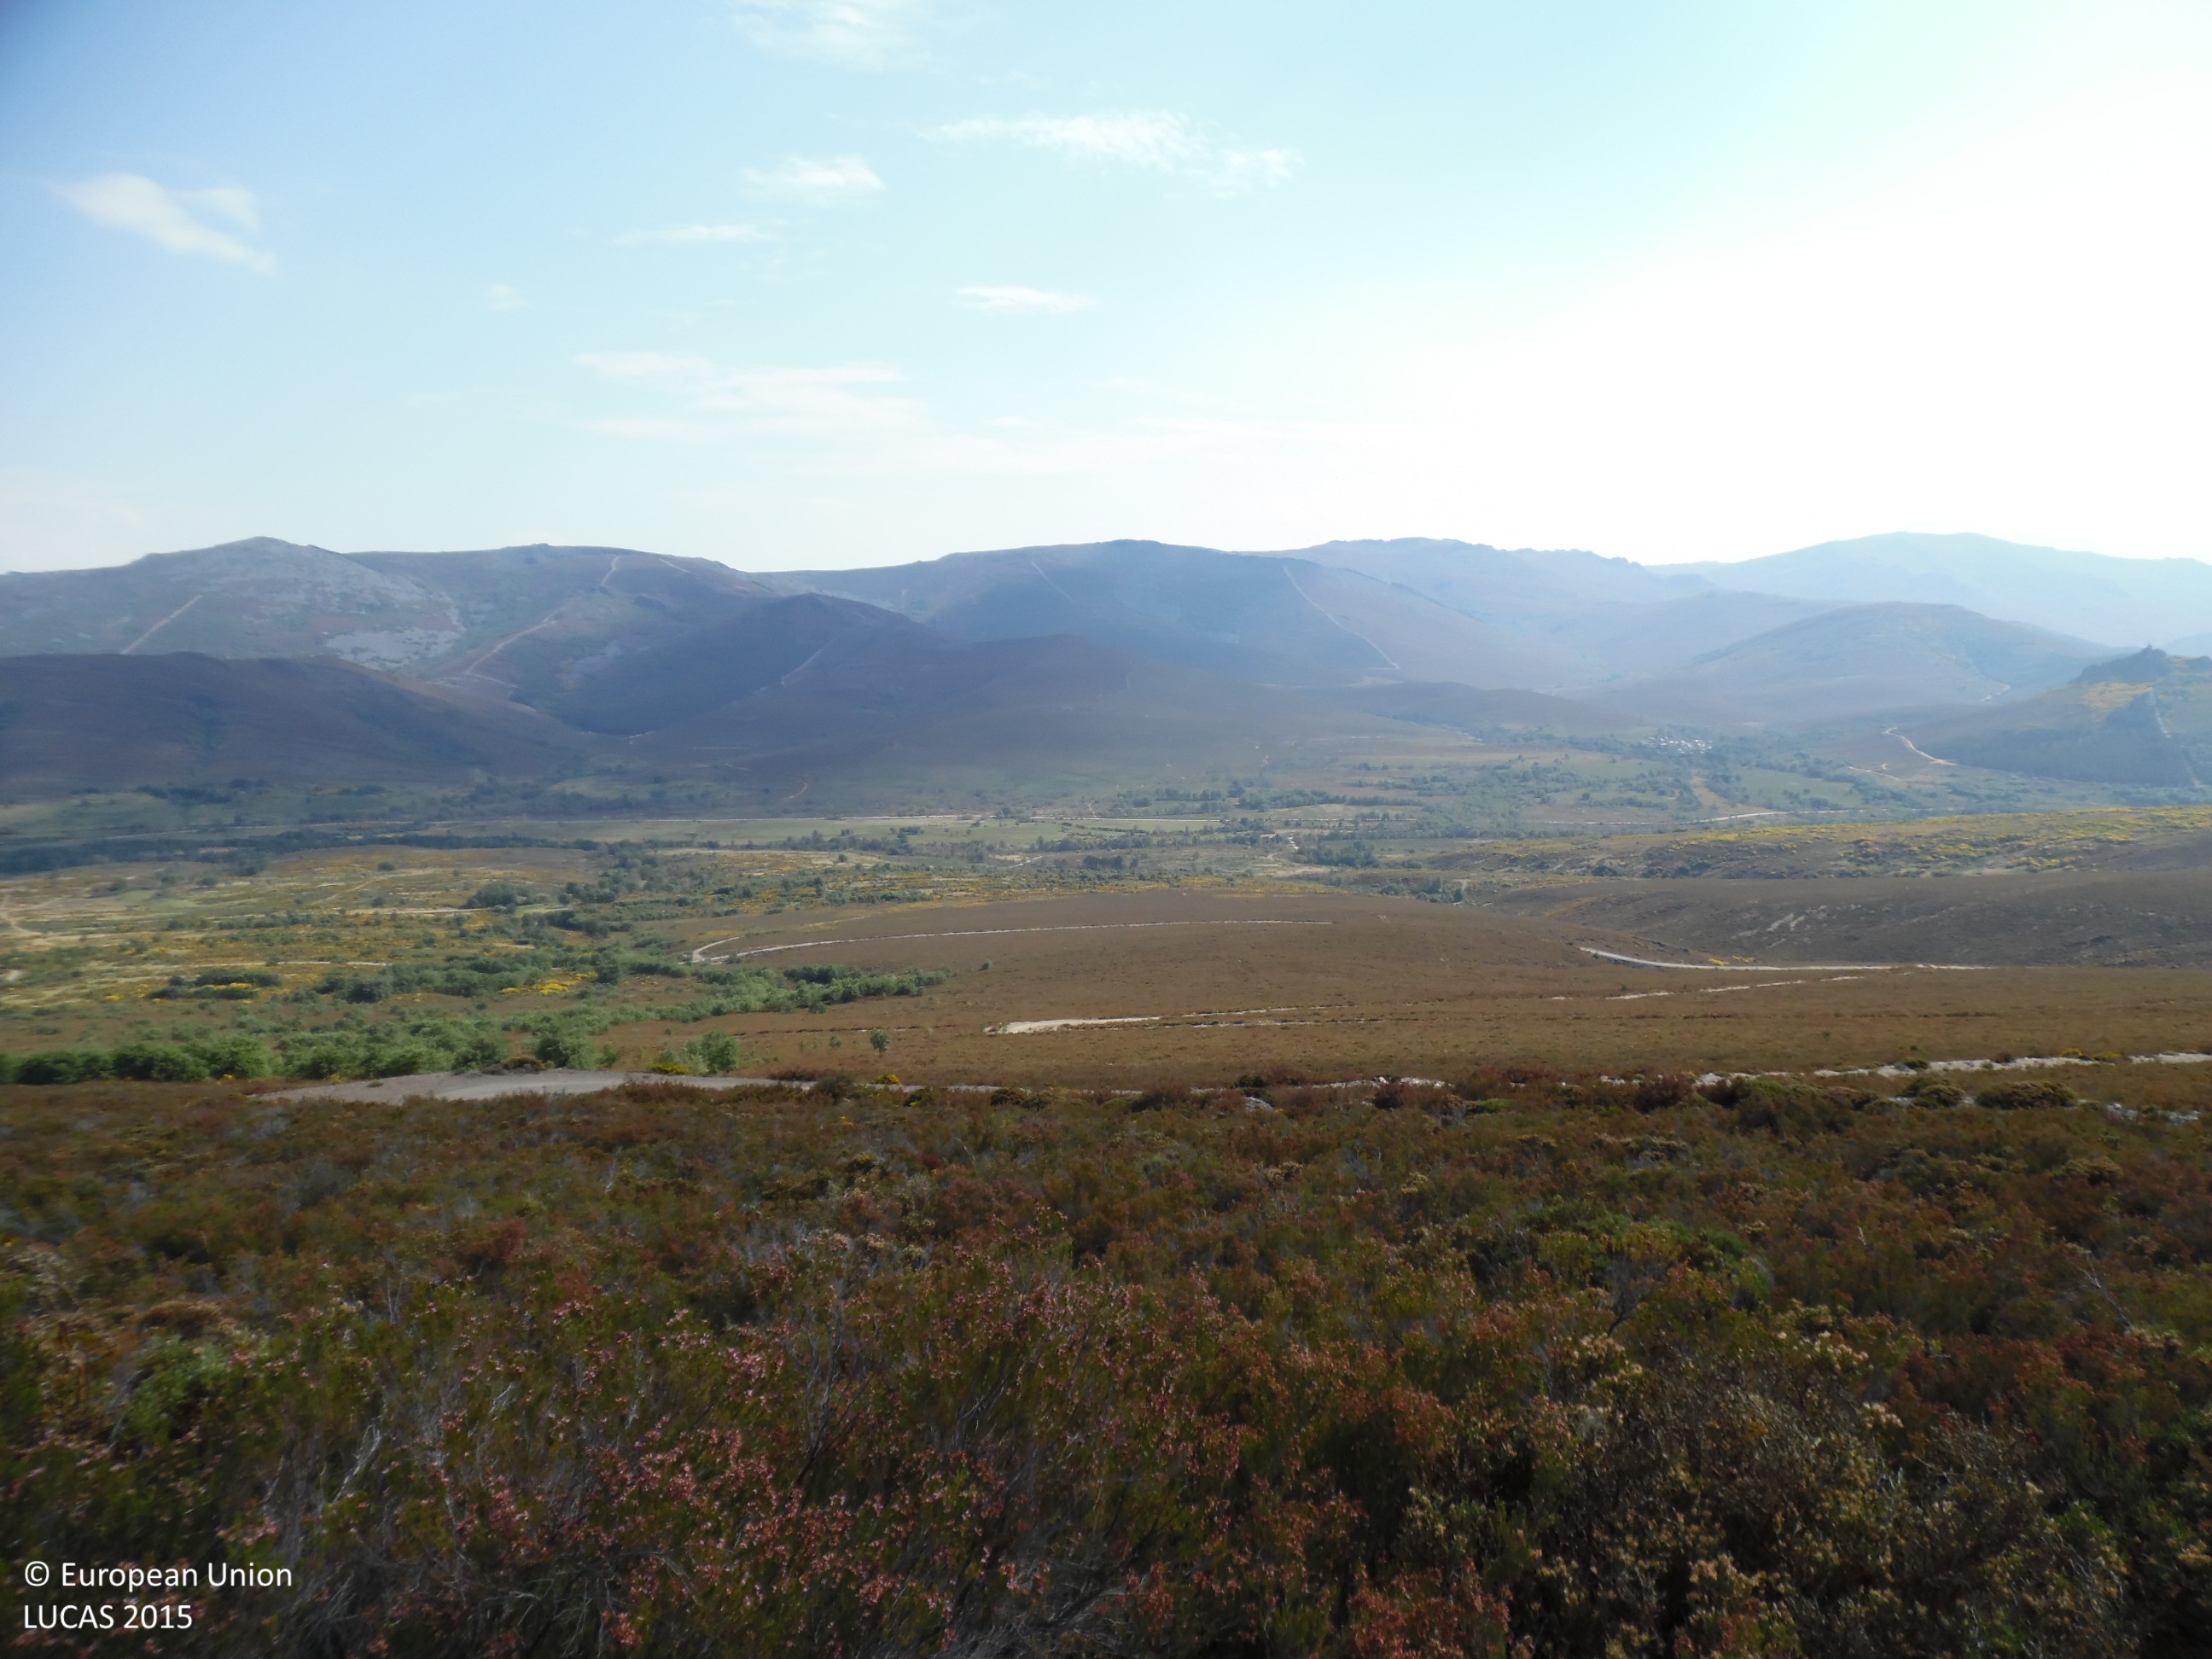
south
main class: Shrubland
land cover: Shrubland without tree cover
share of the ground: > 75 %
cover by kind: shrubs 90 %, unconsolidated bare surface 10 %
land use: Semi-natural and natural areas not in use
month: June
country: ES
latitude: 42.2642
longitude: -6.3922
